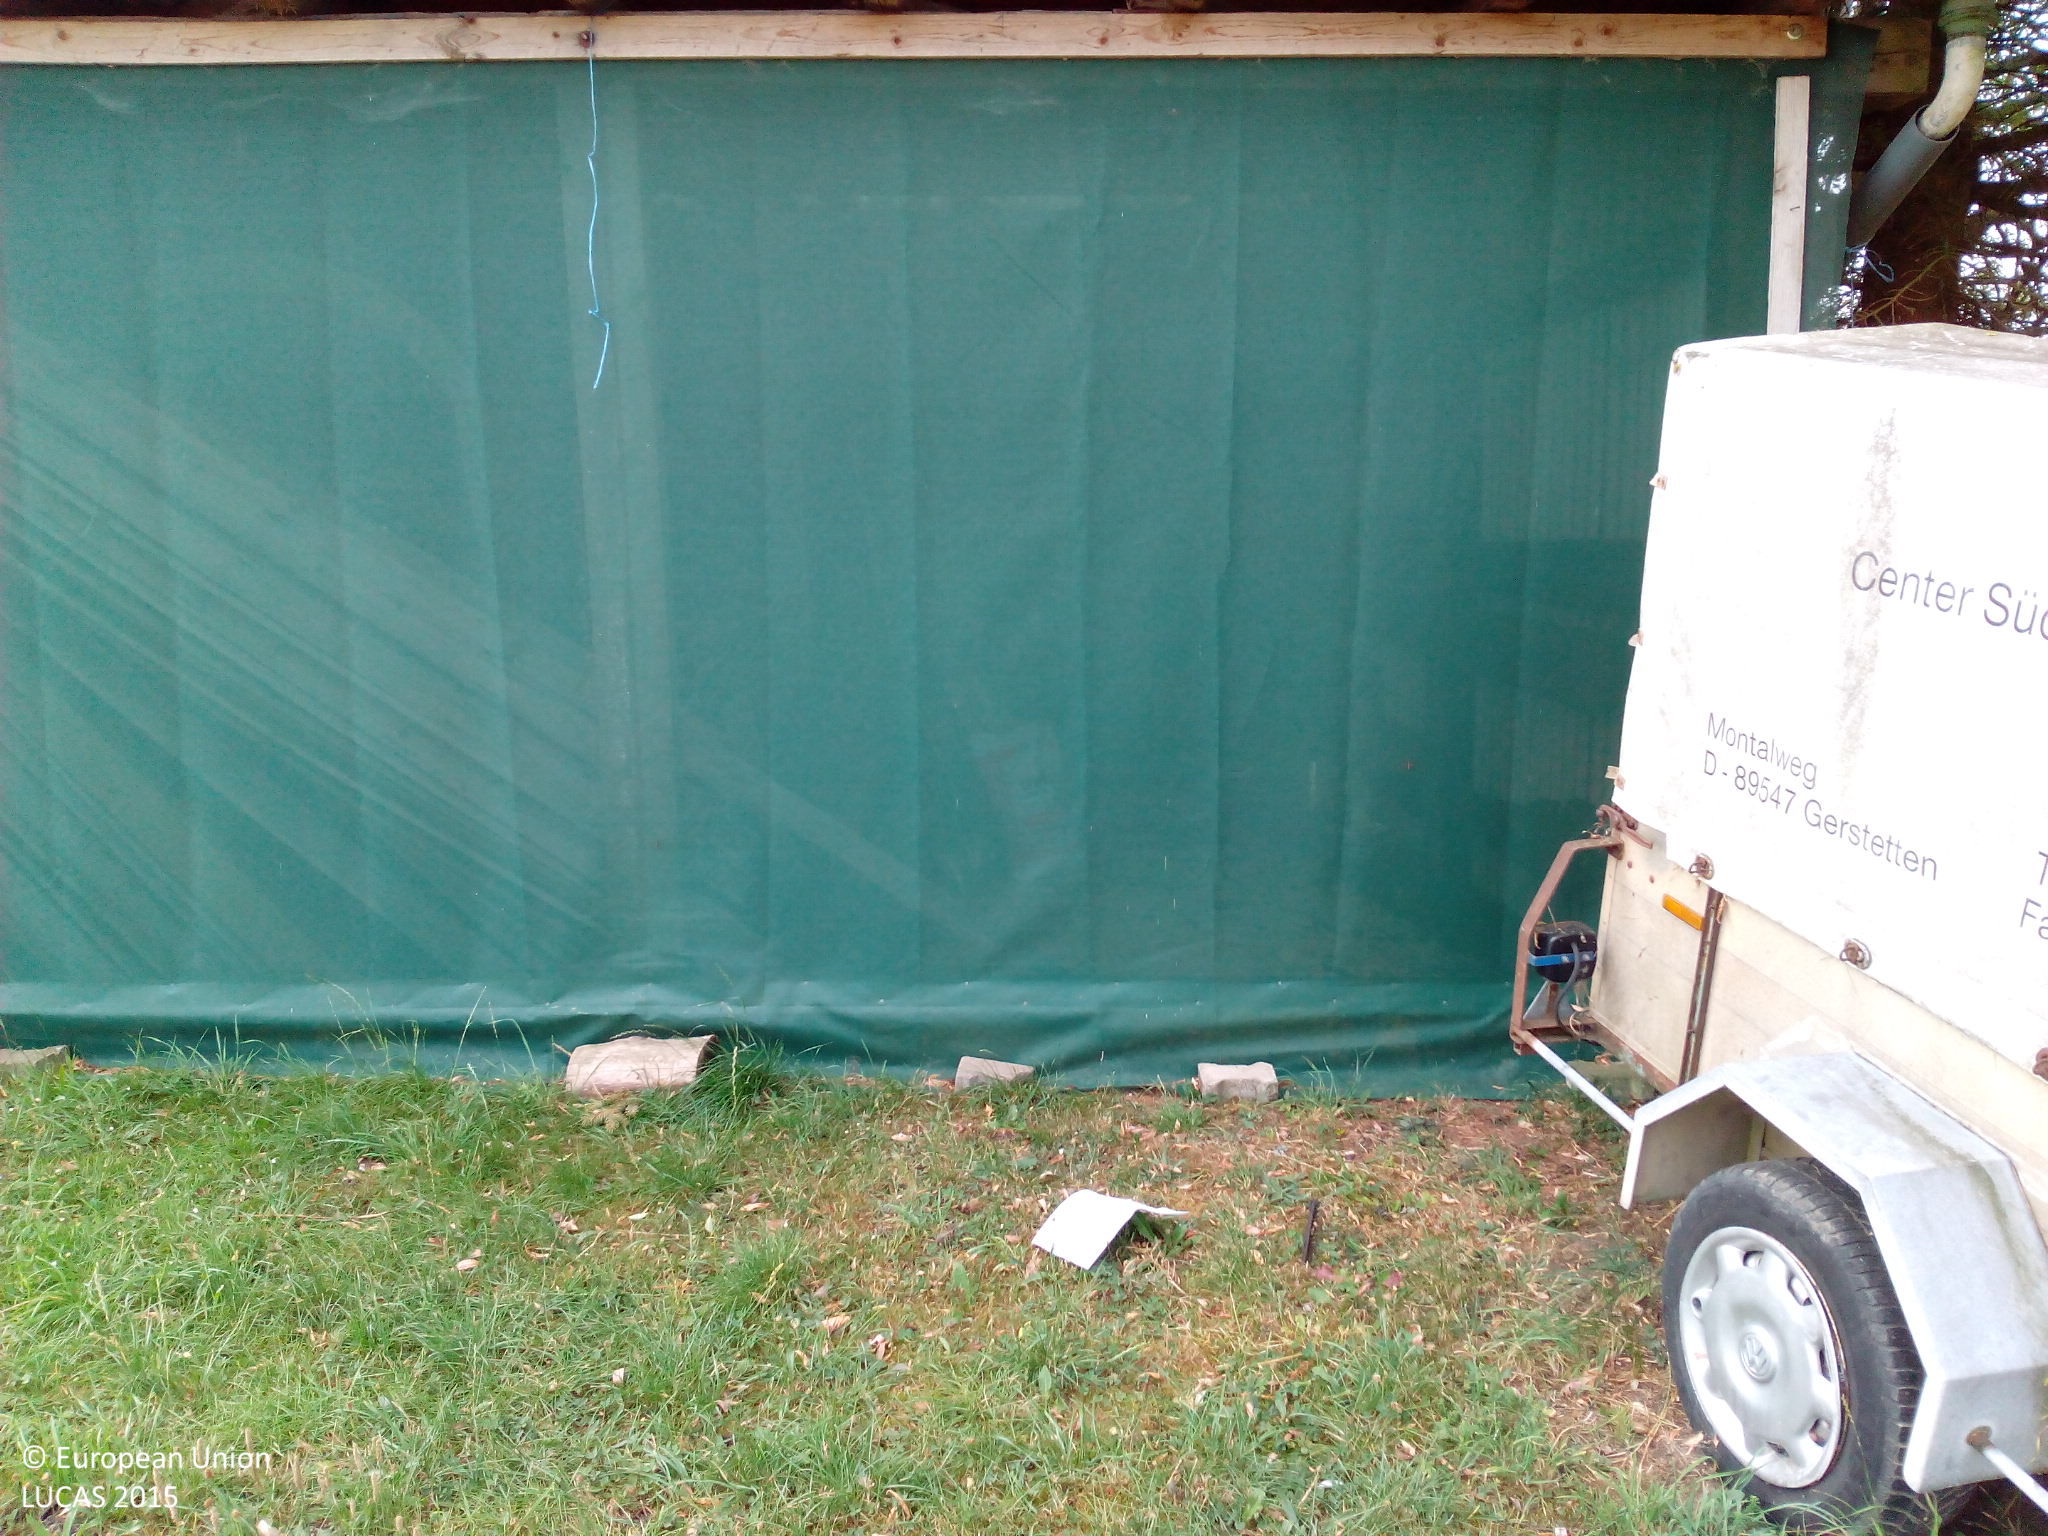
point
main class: Grassland
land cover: Grassland without tree/shrub cover
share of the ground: > 75 %
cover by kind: herbaceous plants 100 %
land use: Agriculture (excluding fallow land and kitchen gardens)
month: August
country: DE
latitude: 48.6554
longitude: 9.9593
